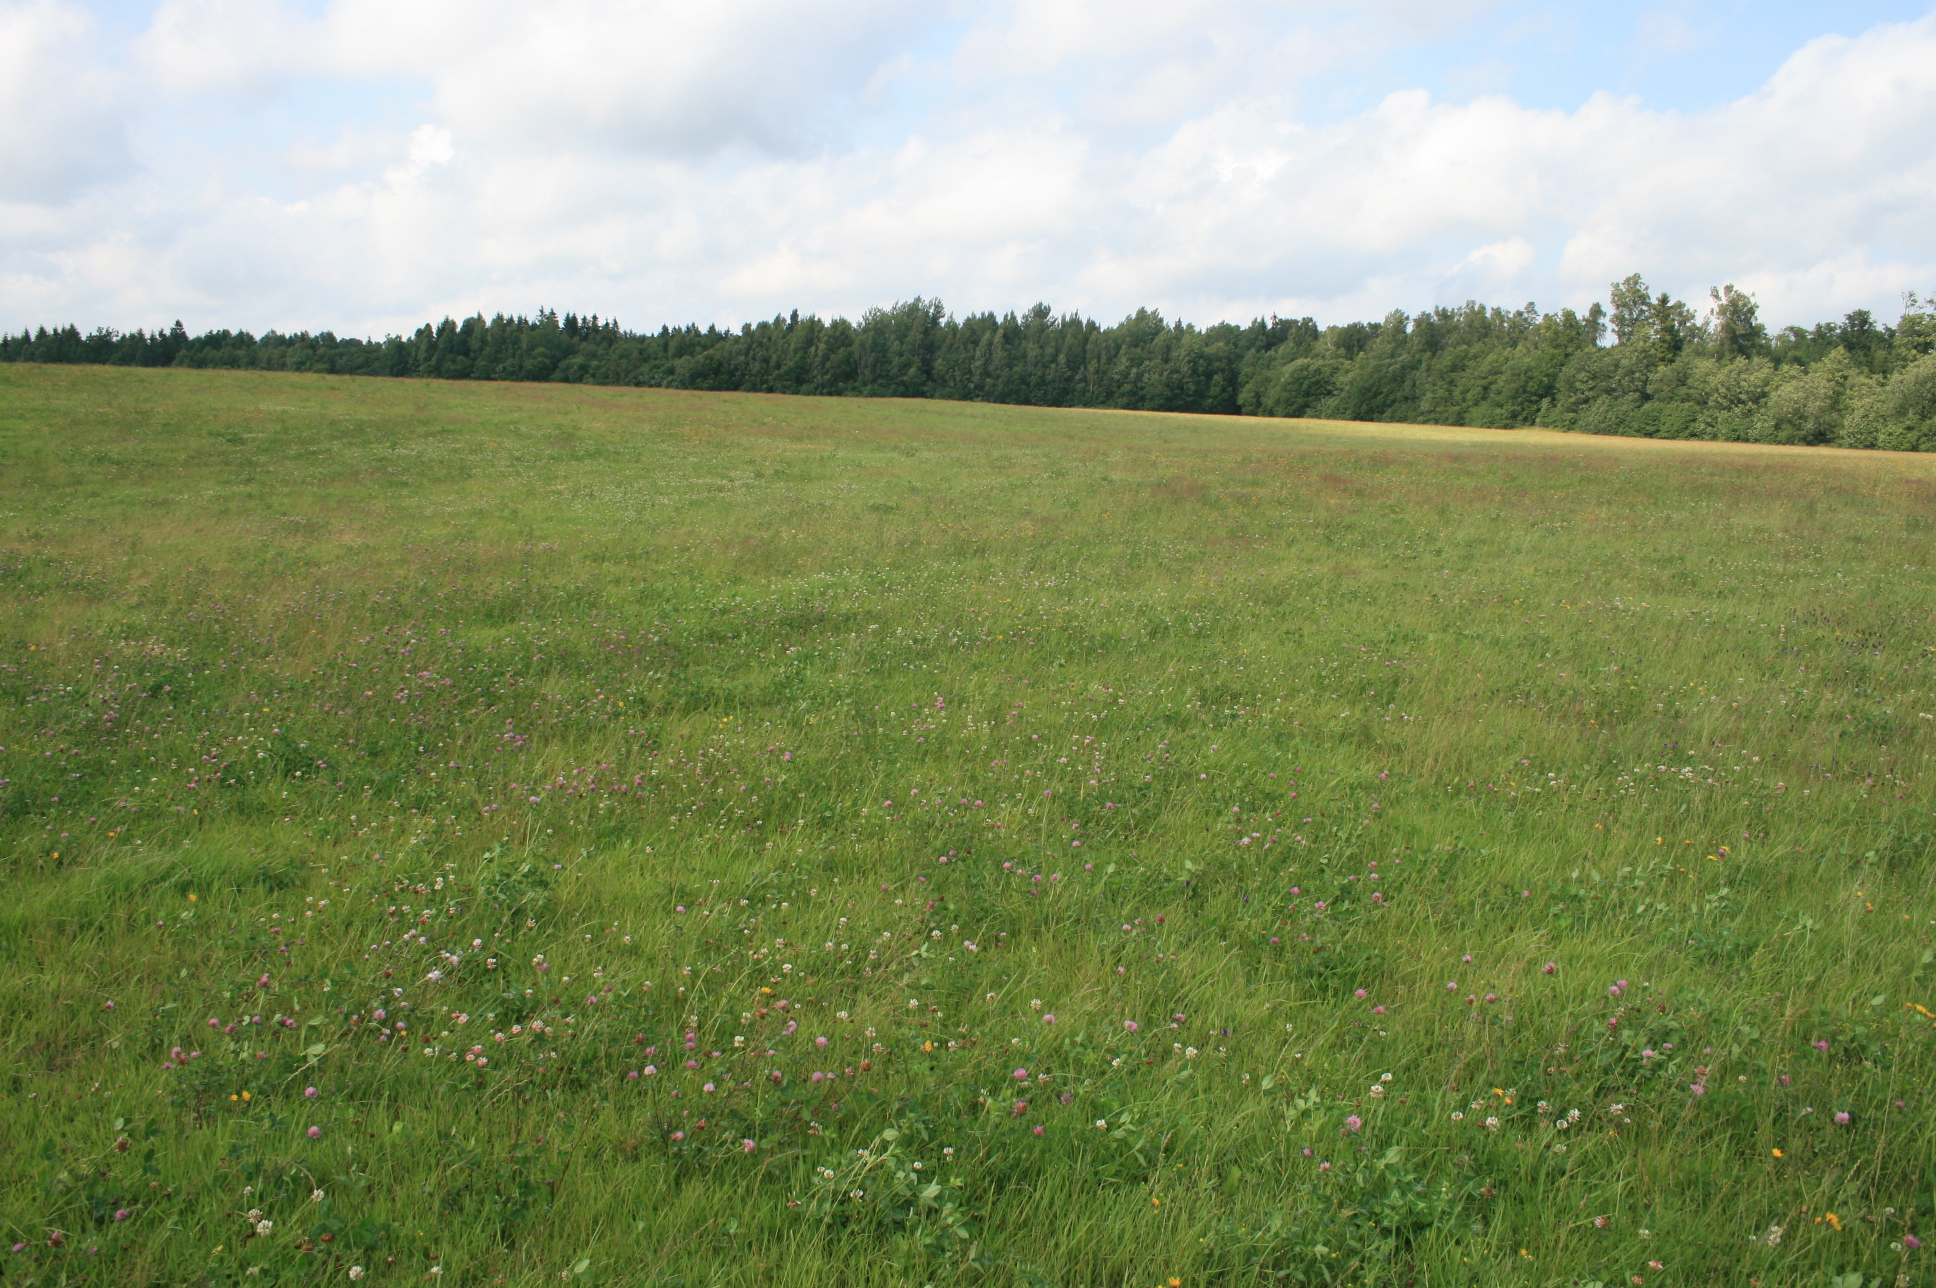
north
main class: Grassland
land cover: Grassland without tree/shrub cover
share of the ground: > 75 %
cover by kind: herbaceous plants 100 %
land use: Agriculture (excluding fallow land and kitchen gardens)
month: July
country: LT
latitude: 55.5299
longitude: 21.8214
